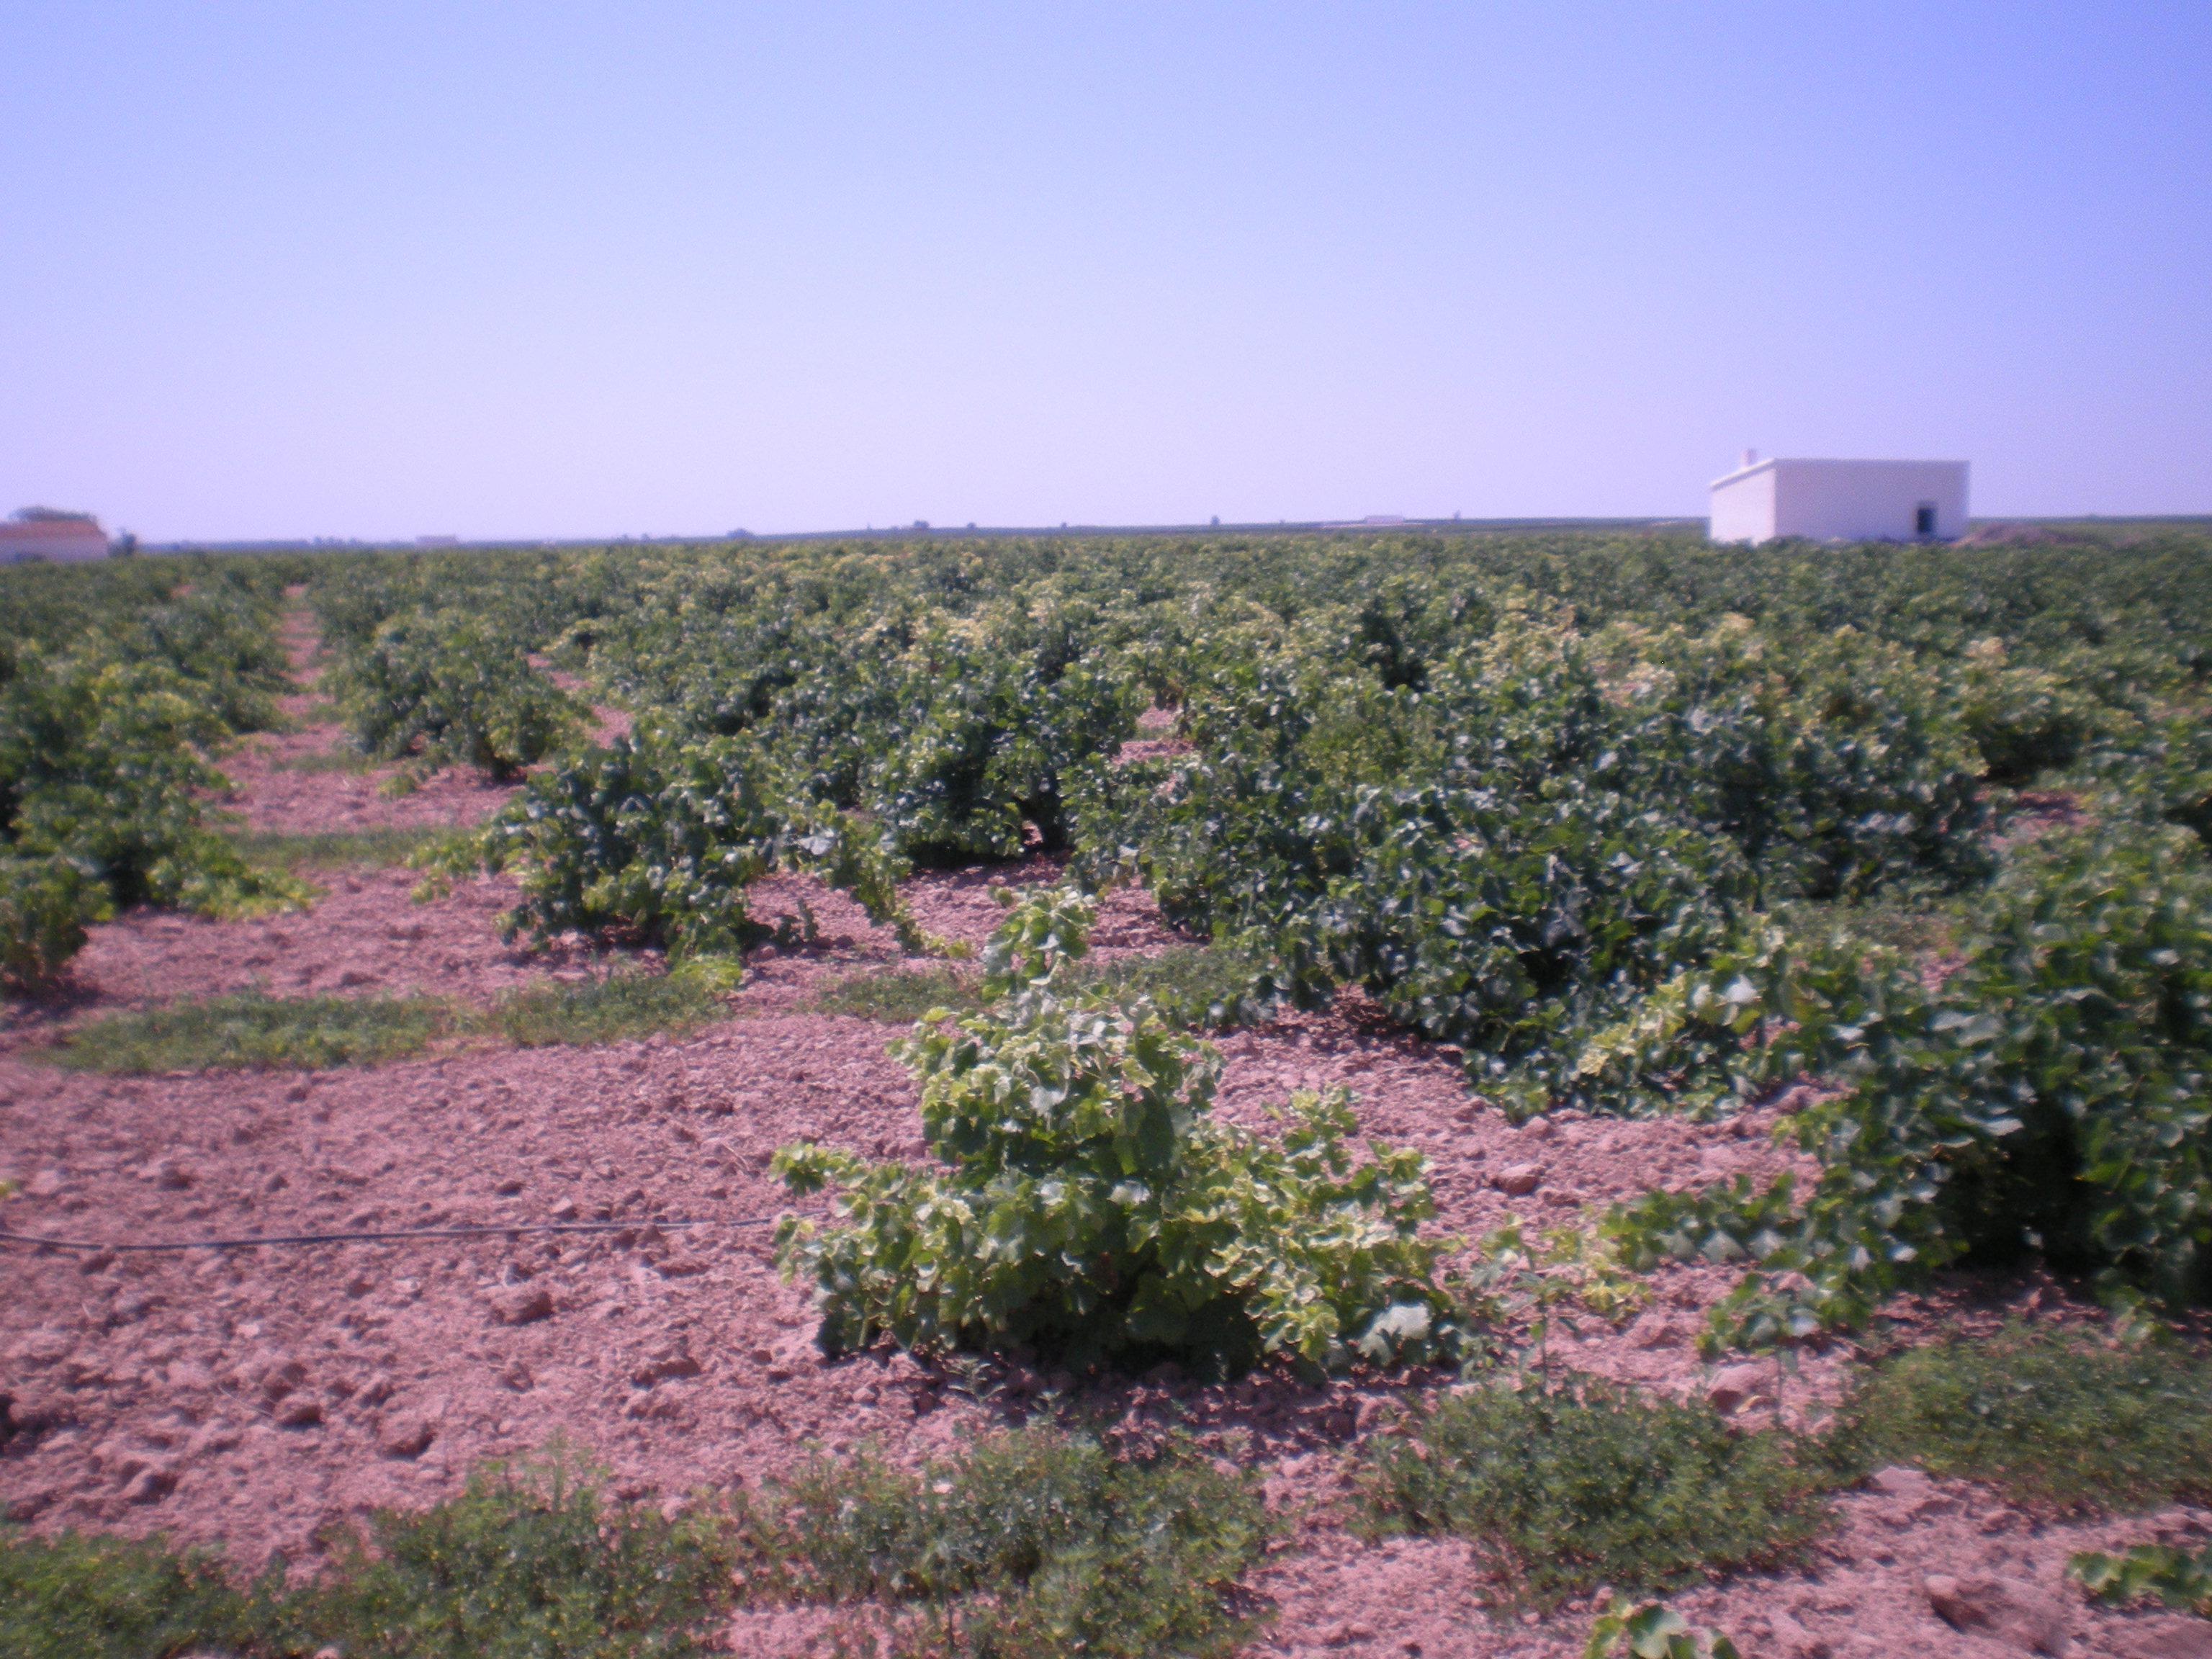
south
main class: Cropland
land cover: Vineyards
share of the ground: 25 - 50 %
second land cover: Spontaneously vegetated surfaces
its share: 10 - 25 %
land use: Agriculture (excluding fallow land and kitchen gardens)
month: July
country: ES
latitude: 39.2631
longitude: -3.0529
